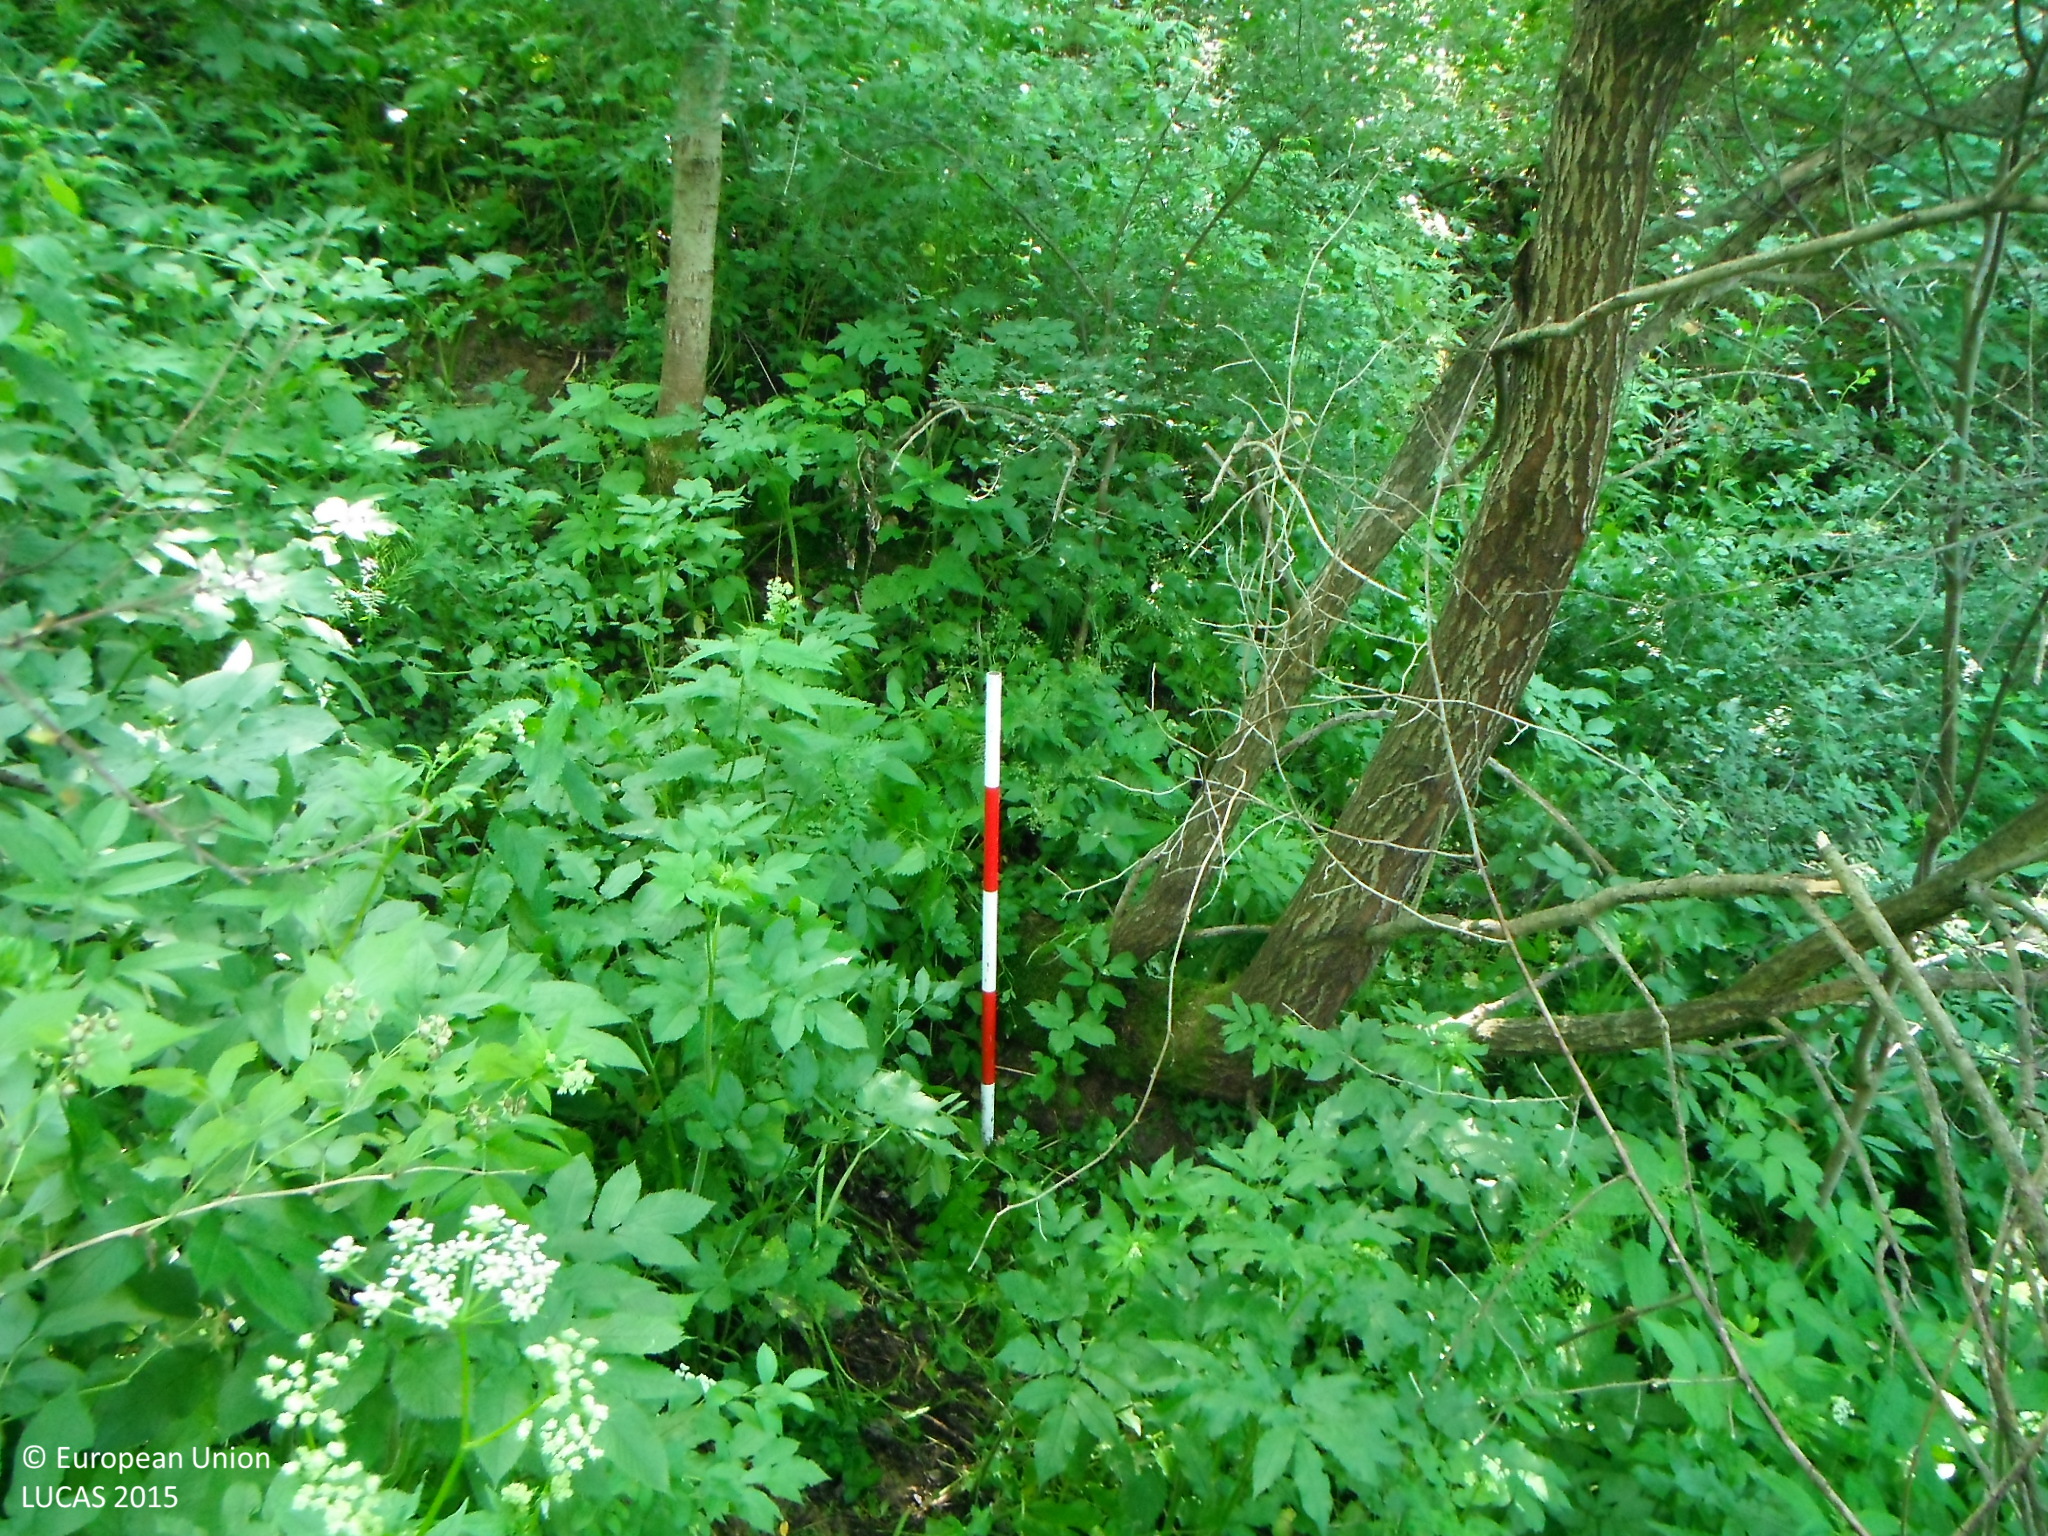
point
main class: Woodland
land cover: Broadleaved woodland
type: hemiboreal forest and nemoral coniferous forest and mixed broadleaved-coniferous forest
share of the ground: > 75 %
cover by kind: broadleaved forest trees 95 %, coniferous forest trees 5 %
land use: Semi-natural and natural areas not in use
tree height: > 5 m
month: June
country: SK
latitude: 49.2264
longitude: 19.4871
